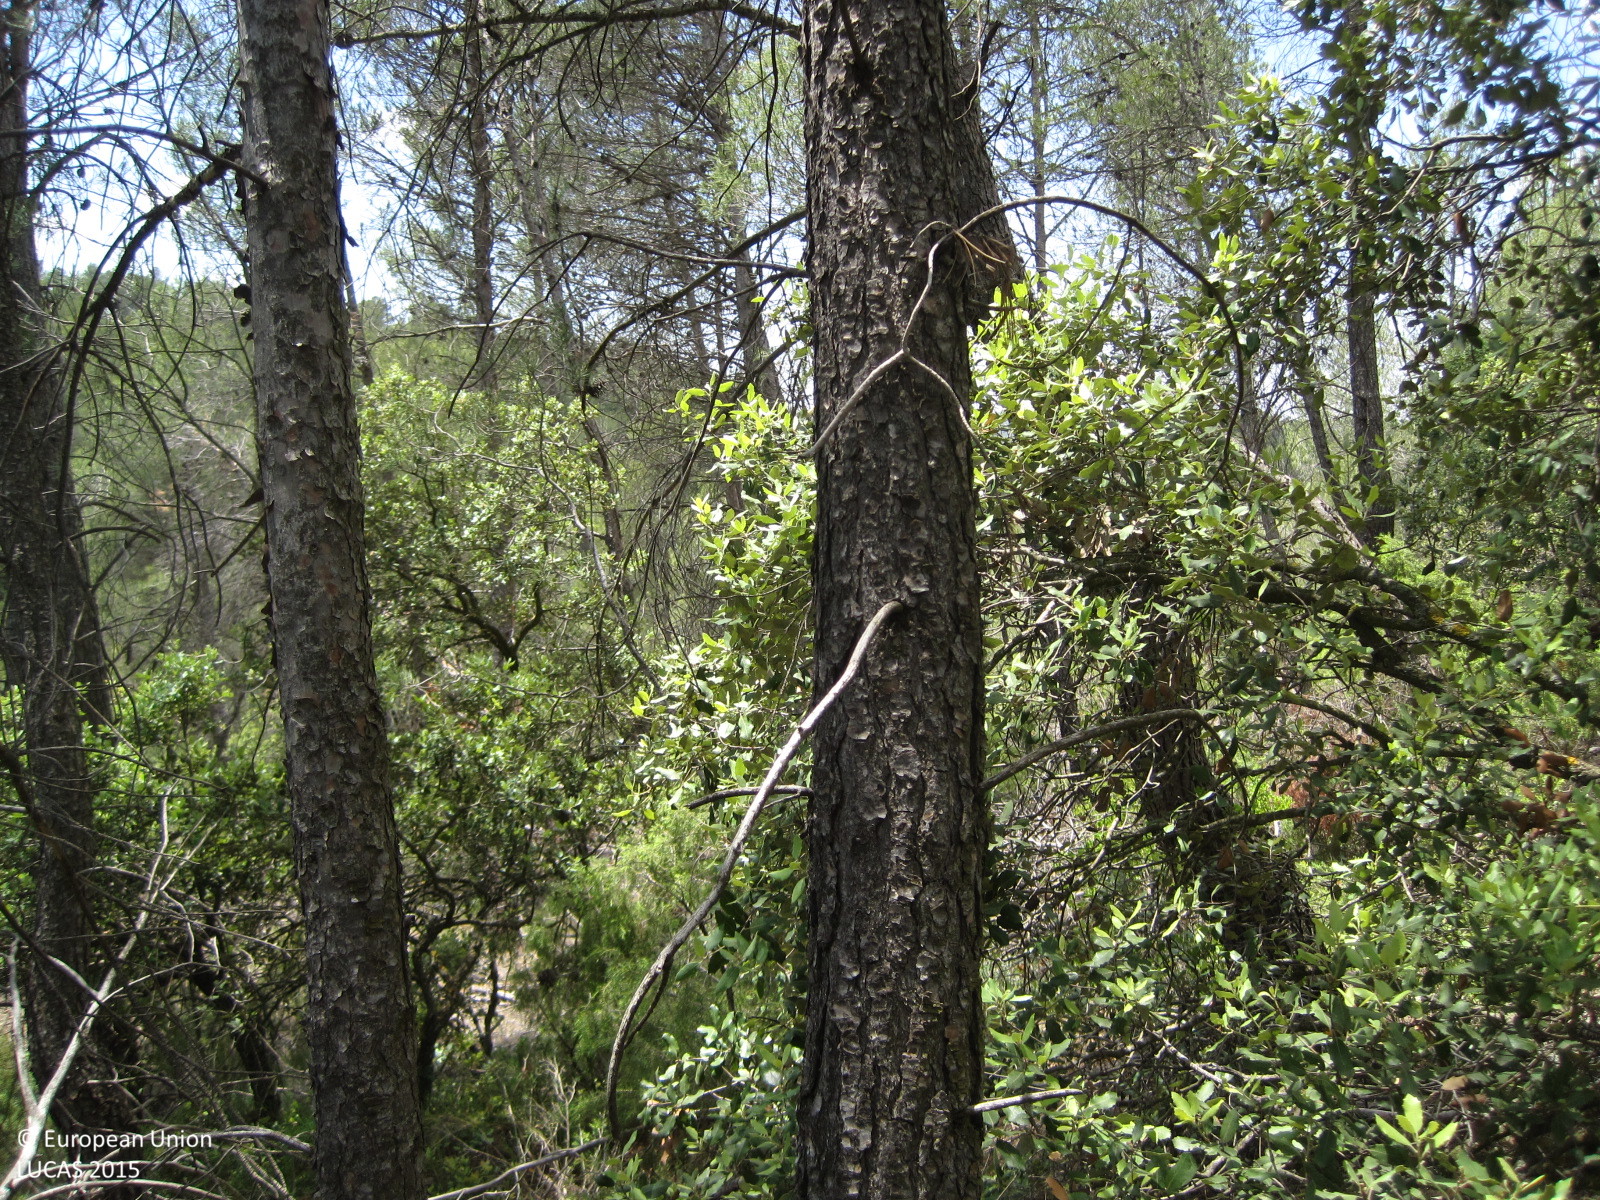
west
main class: Woodland
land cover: Pine dominated coniferous woodland
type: coniferous forest of the mediterranean region
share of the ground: 50 - 75 %
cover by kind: coniferous forest trees 60 %, shrubs 20 %, broadleaved forest trees 15 %, herbaceous plants 5 %
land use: Forestry
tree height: > 5 m
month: May
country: ES
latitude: 39.5988
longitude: -1.1006
